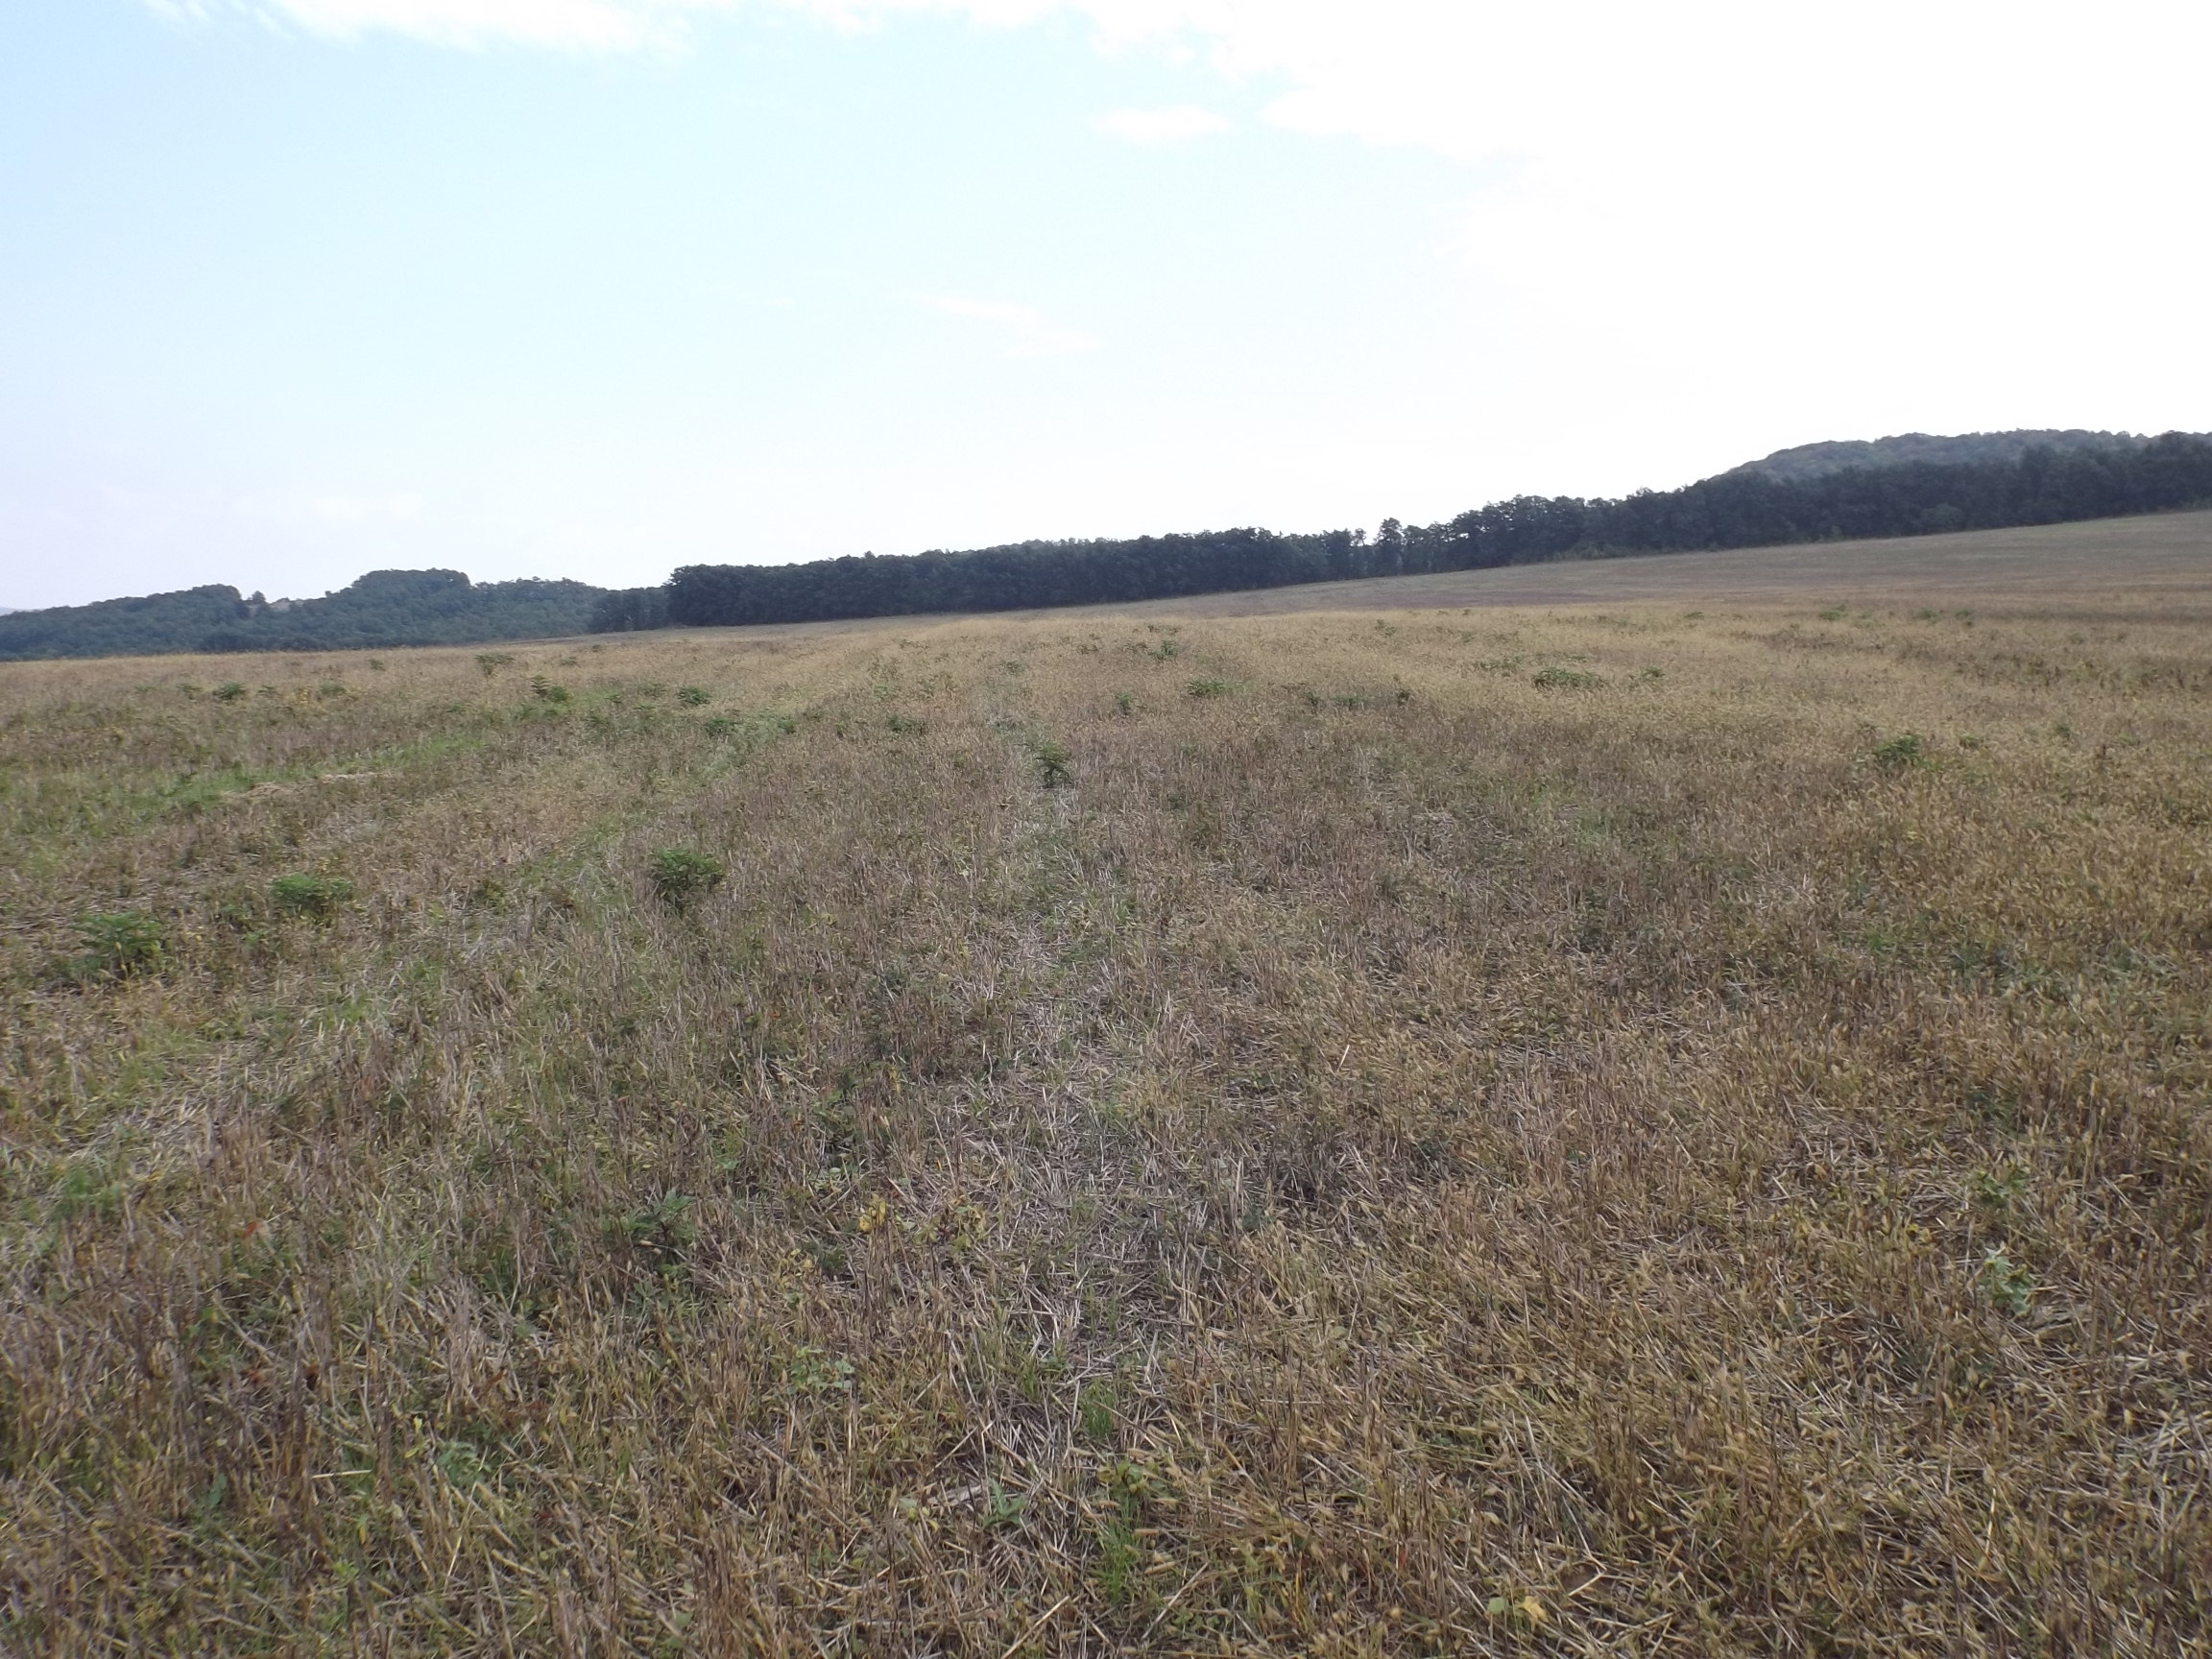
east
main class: Cropland
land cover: Common wheat
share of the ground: 10 - 25 %
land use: Agriculture (excluding fallow land and kitchen gardens)
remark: Harvested field
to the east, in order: Common wheat
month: October
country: BG
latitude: 43.0206
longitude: 27.3616
